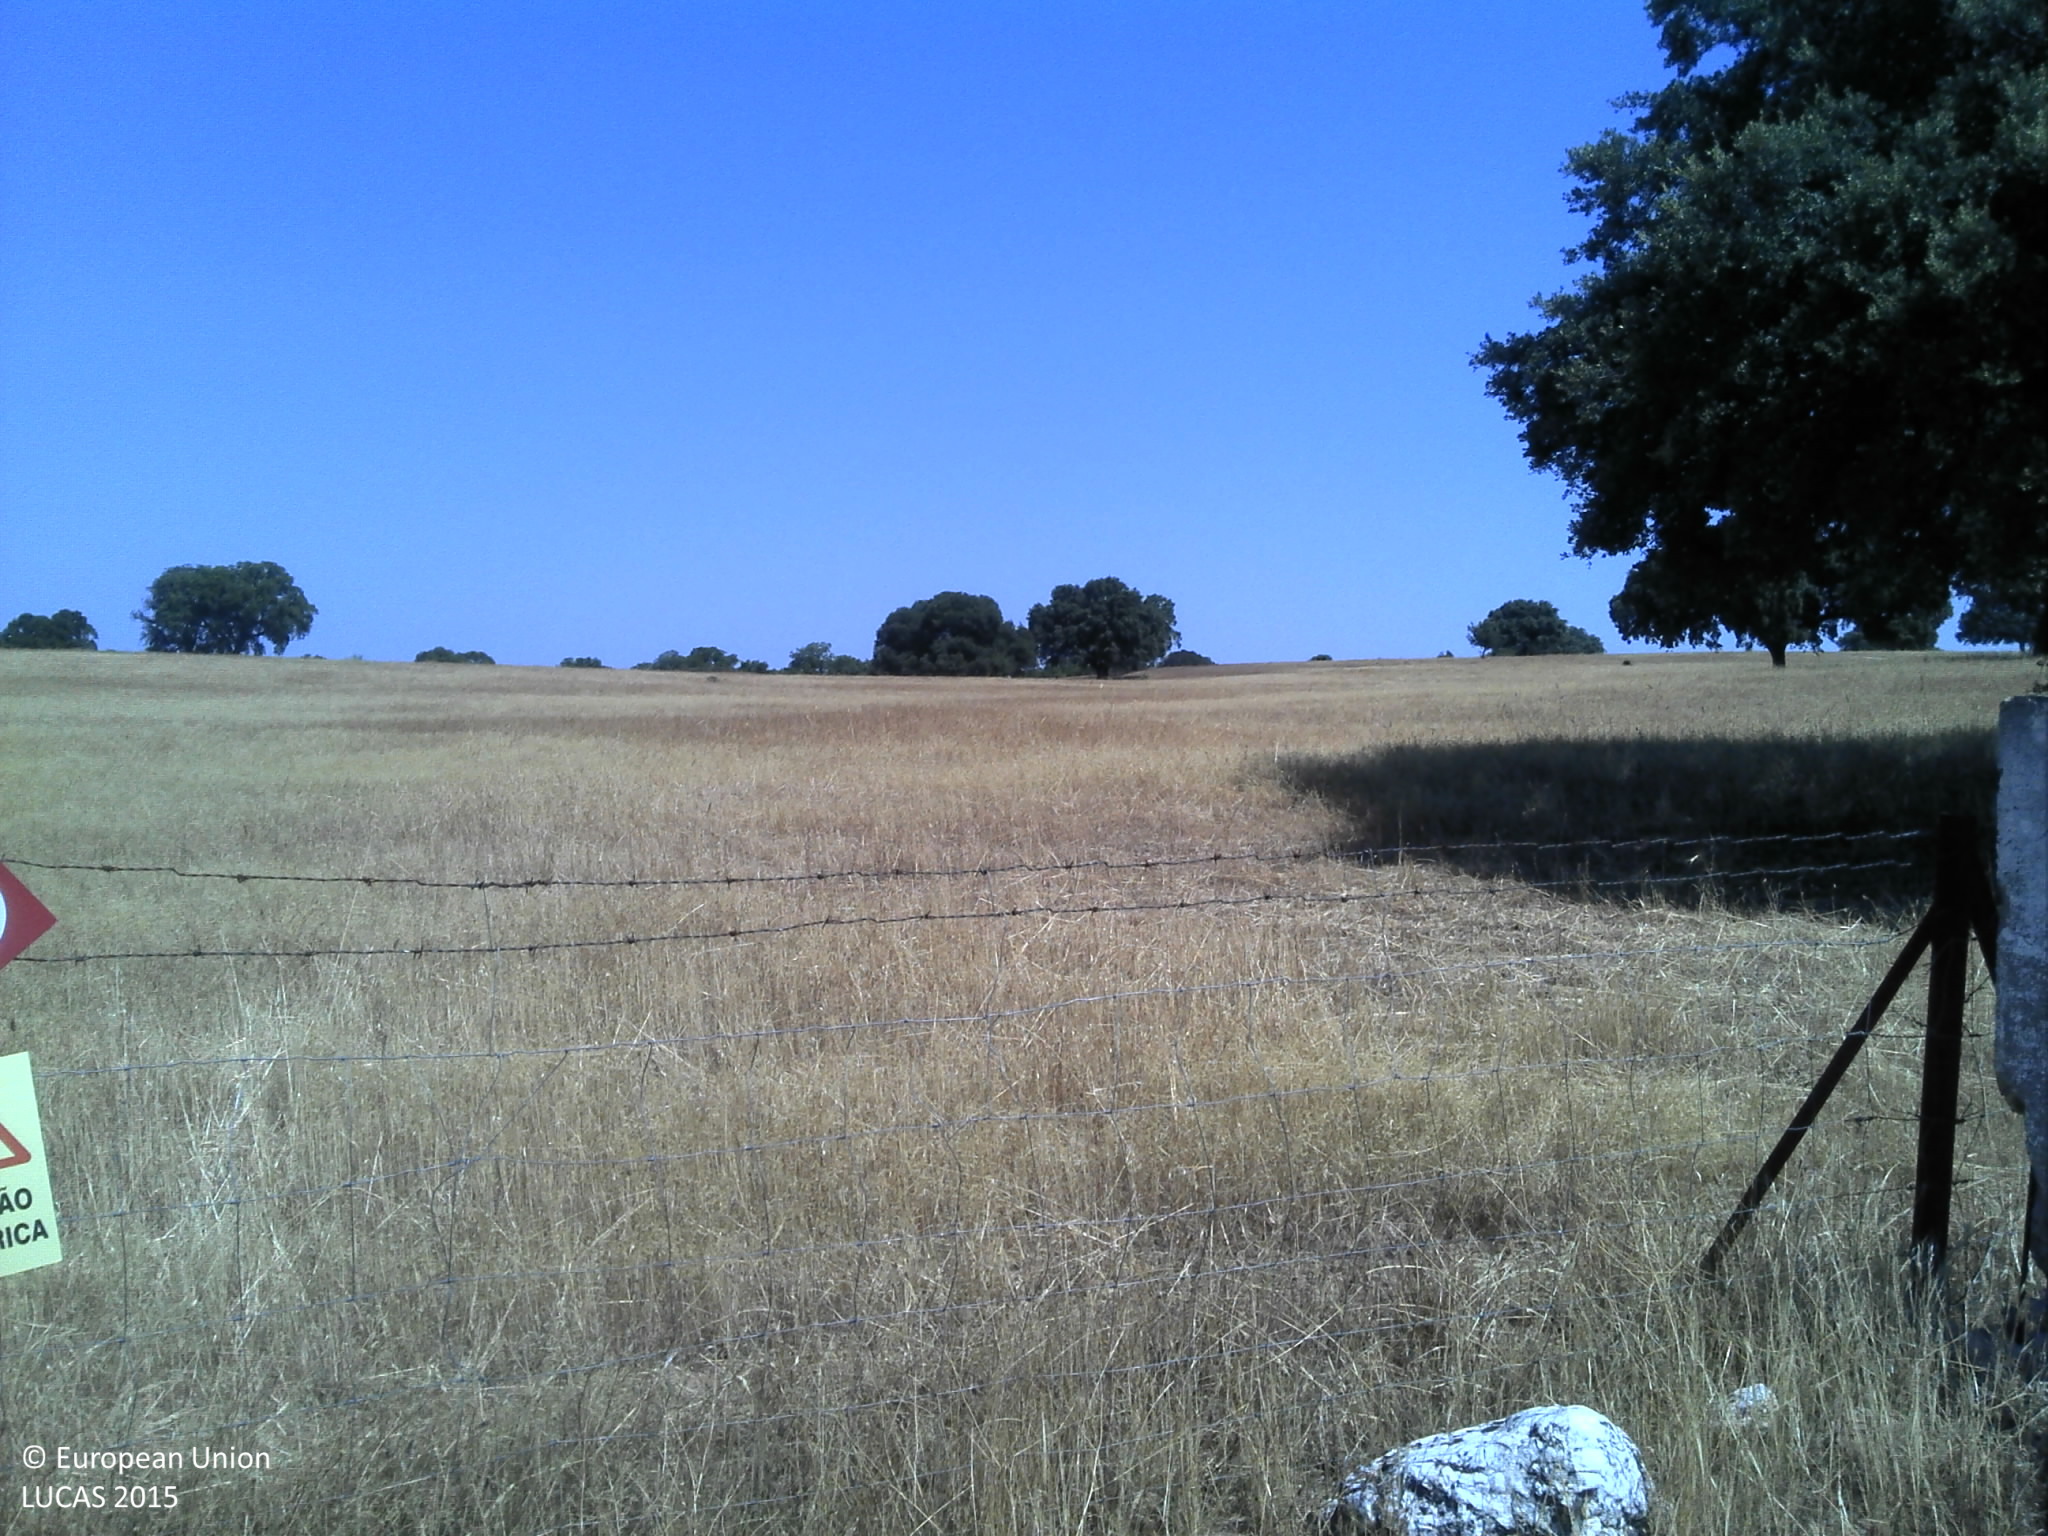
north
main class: Grassland
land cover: Grassland with sparse tree/shrub cover
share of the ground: 50 - 75 %
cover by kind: herbaceous plants 85 %, shrubs 10 %, broadleaved forest trees 5 %
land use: Agriculture (excluding fallow land and kitchen gardens)
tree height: > 5 m
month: June
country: PT
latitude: 39.7656
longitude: -7.2164
